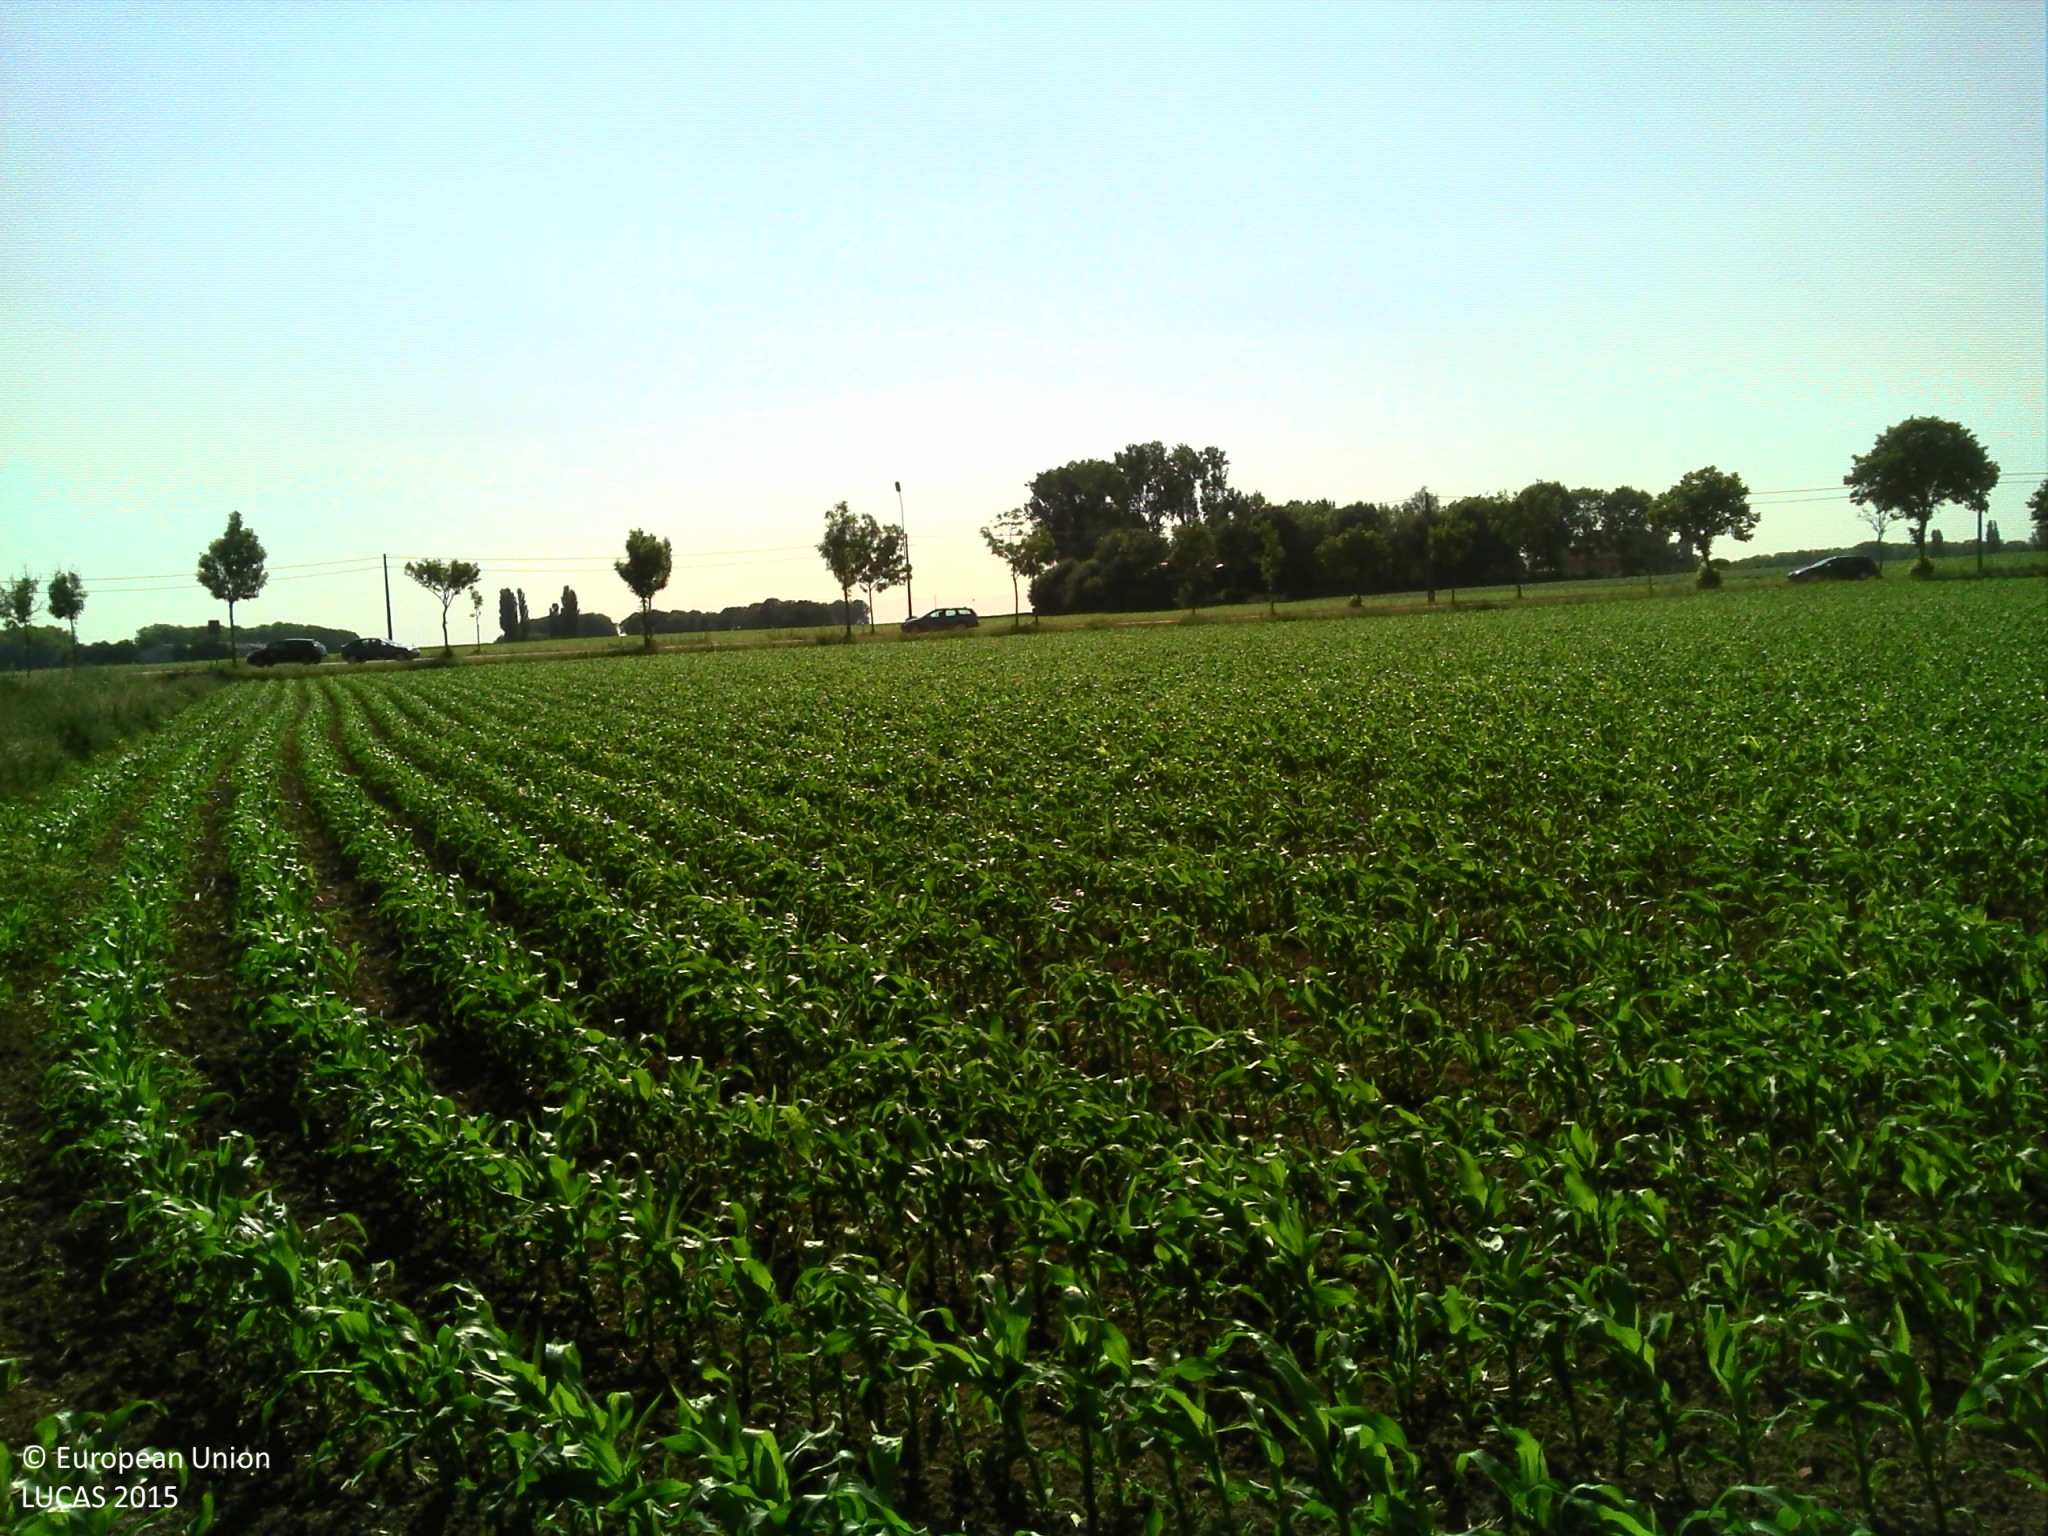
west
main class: Cropland
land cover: Maize
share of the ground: 50 - 75 %
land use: Agriculture (excluding fallow land and kitchen gardens)
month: June
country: BE
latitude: 50.8815
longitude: 2.8683
